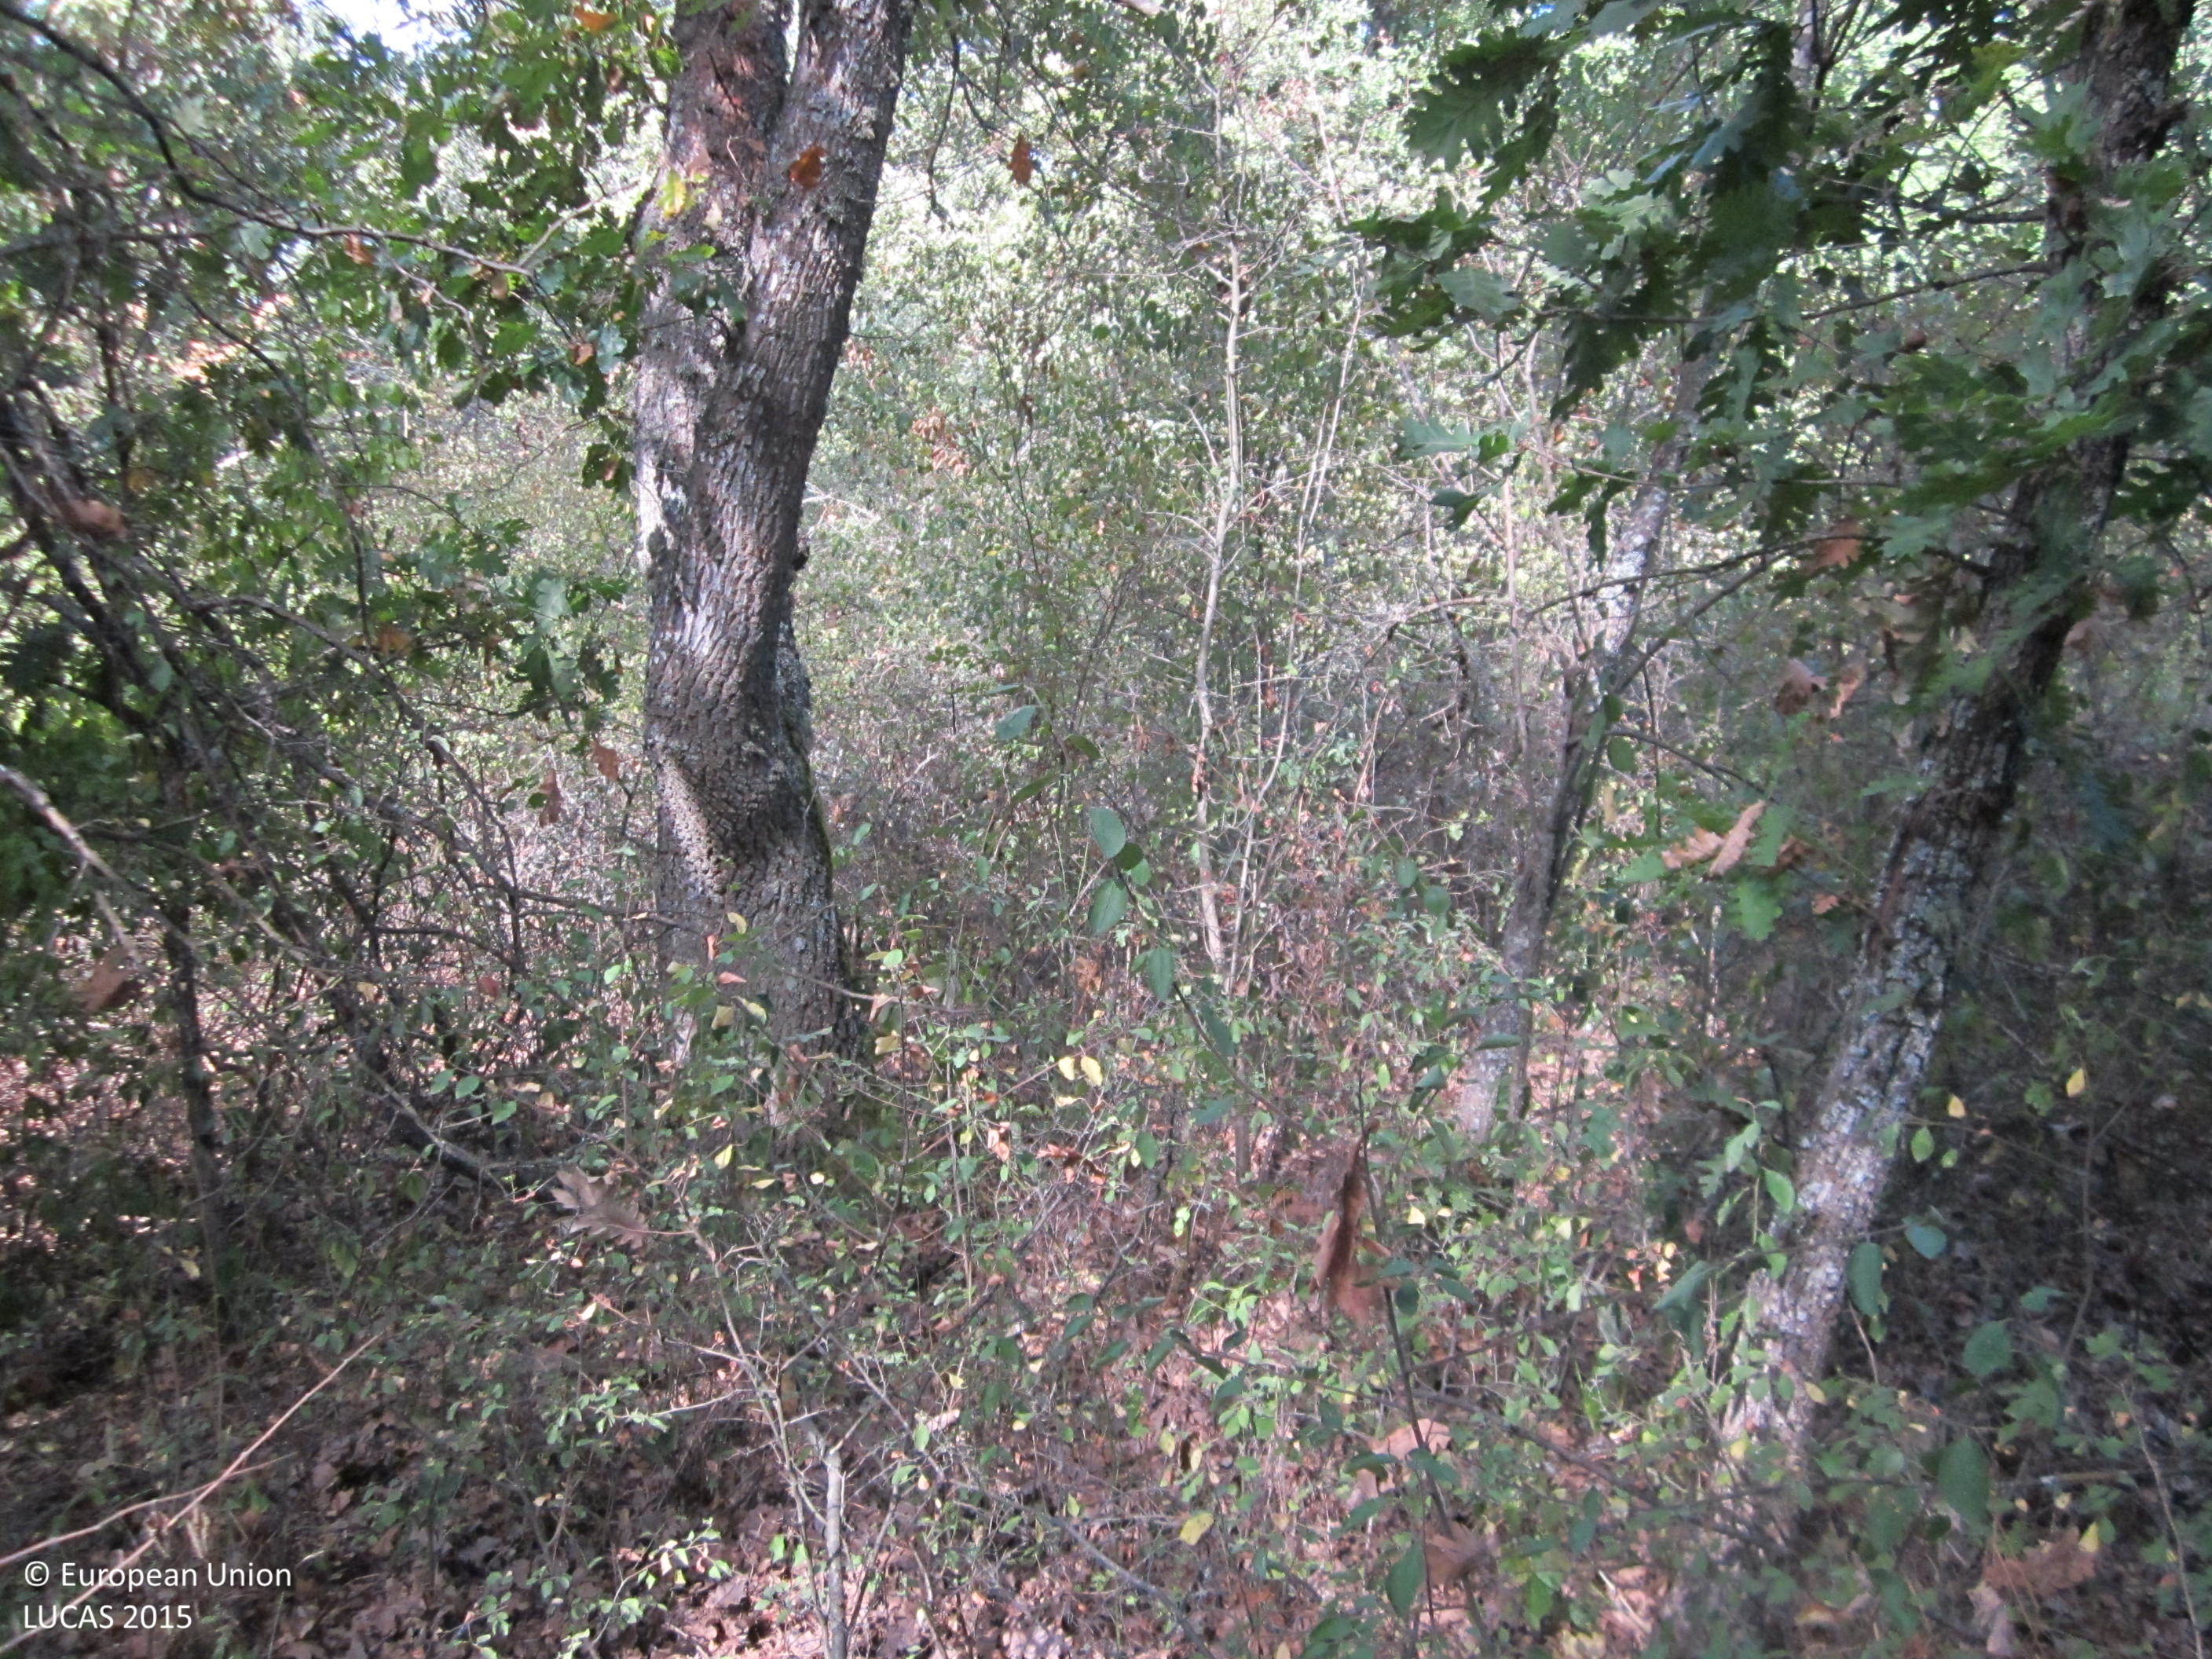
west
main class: Woodland
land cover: Broadleaved woodland
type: thermophilous deciduous forest
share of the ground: > 75 %
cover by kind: broadleaved forest trees 90 %, shrubs 5 %, herbaceous plants 5 %
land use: Forestry
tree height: > 5 m
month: September
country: BG
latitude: 42.1578
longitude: 27.1319
